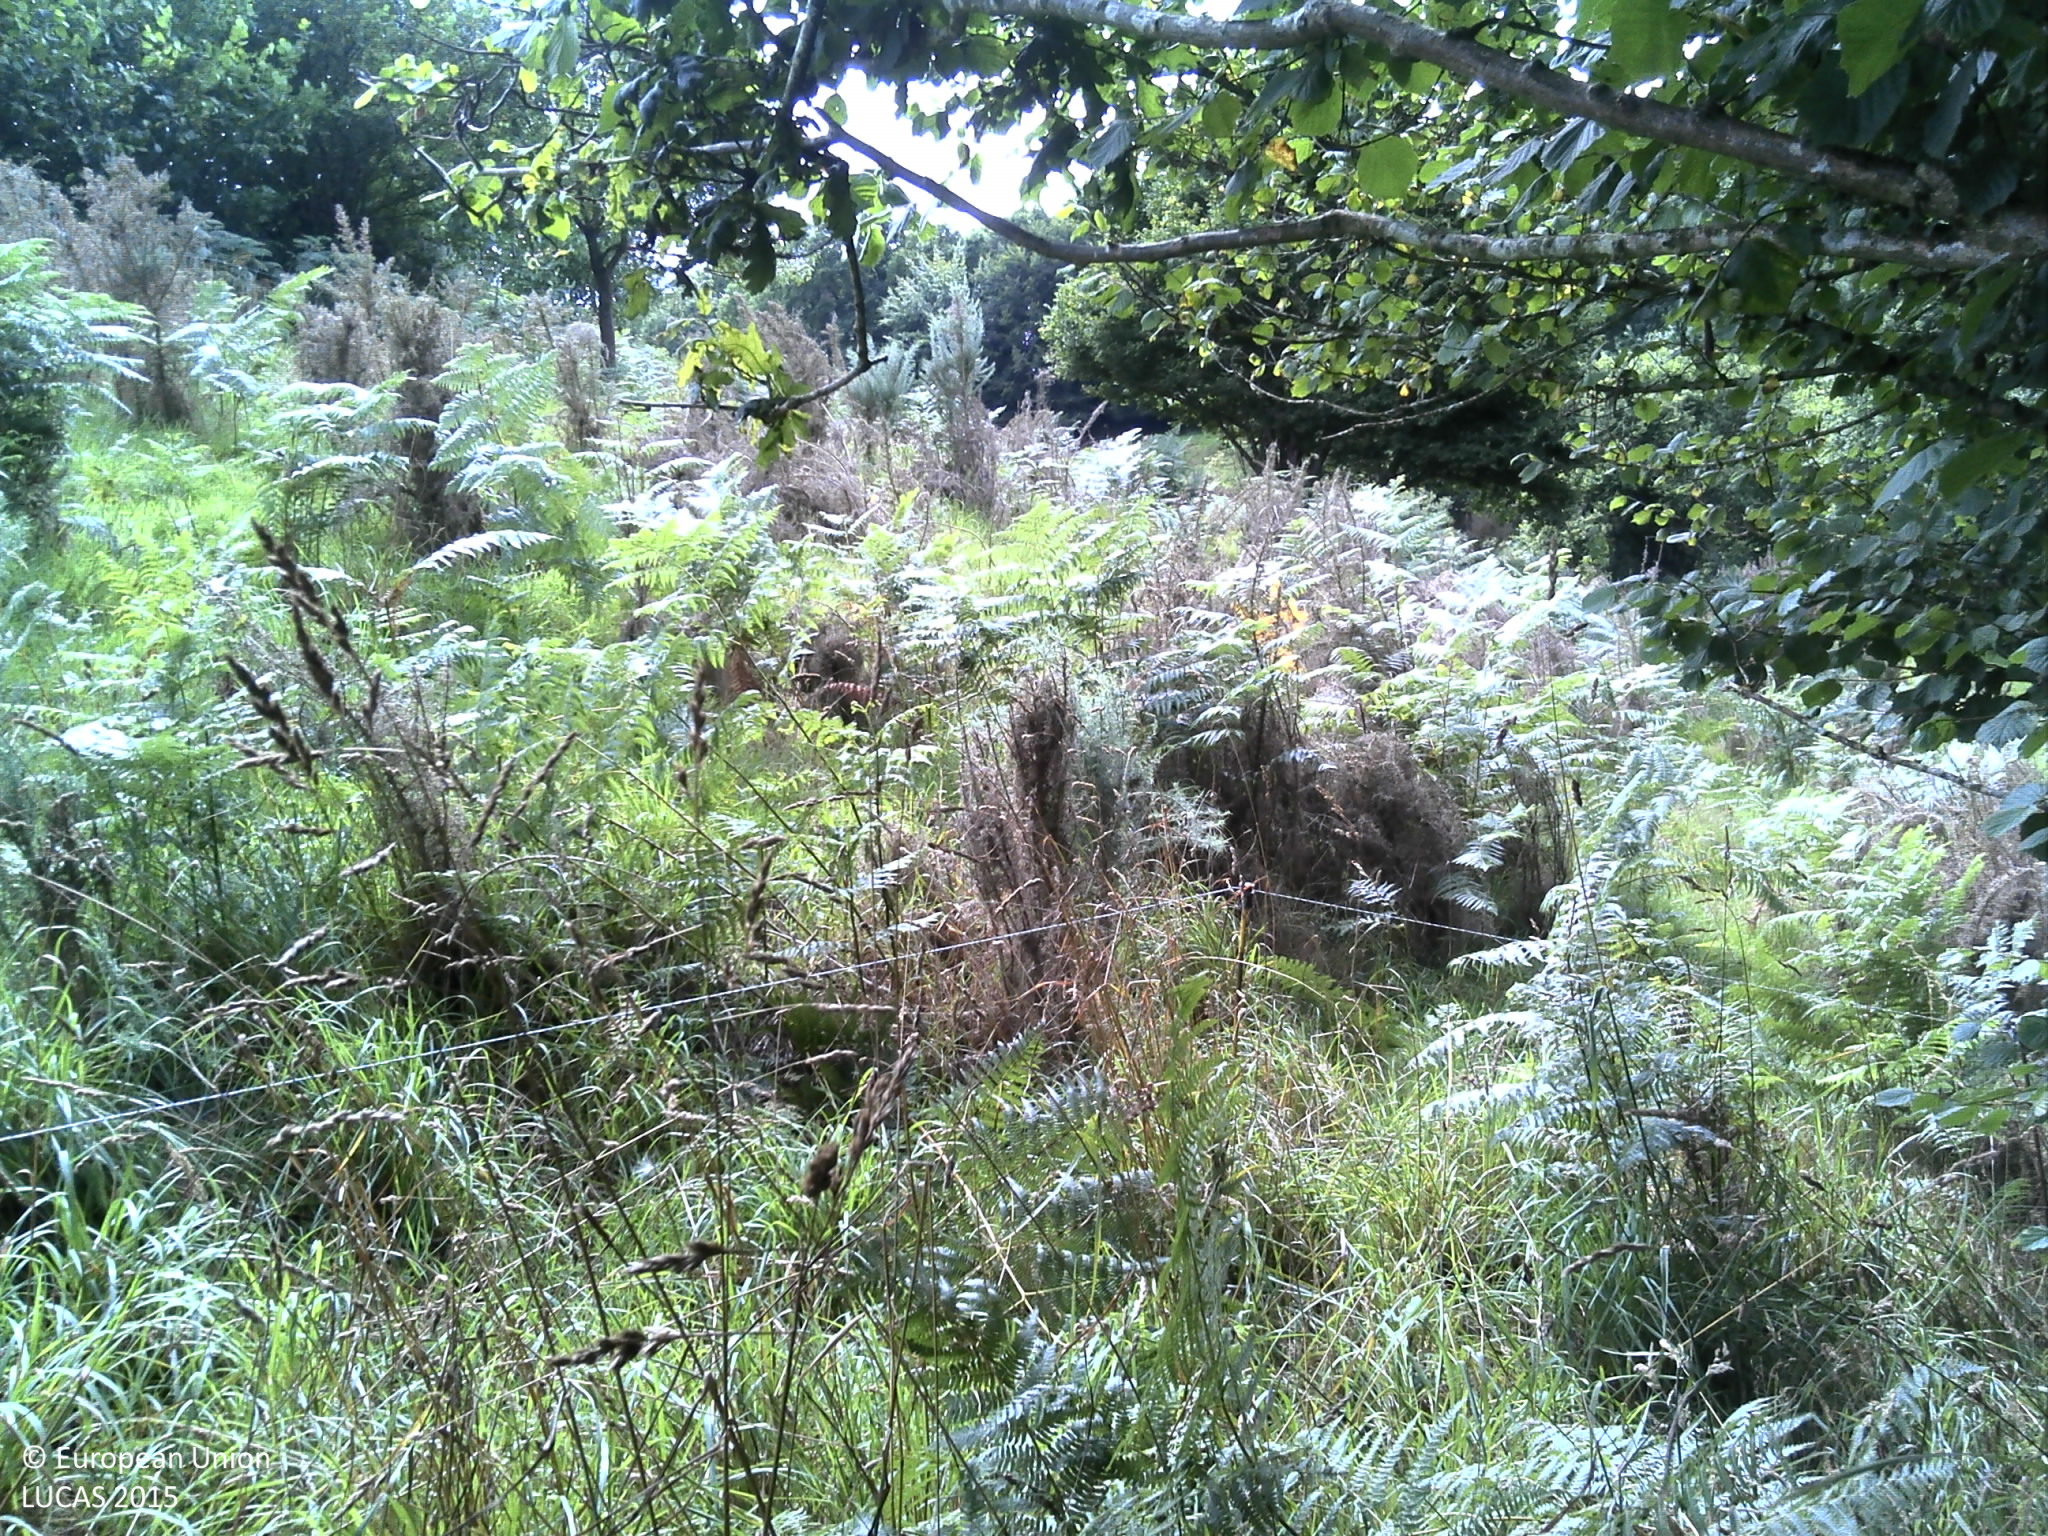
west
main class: Woodland
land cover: Broadleaved woodland
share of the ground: > 75 %
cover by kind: broadleaved forest trees 90 %, herbaceous plants 10 %
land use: Agriculture (excluding fallow land and kitchen gardens)
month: July
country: FR
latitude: 48.2850
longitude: -3.6246
